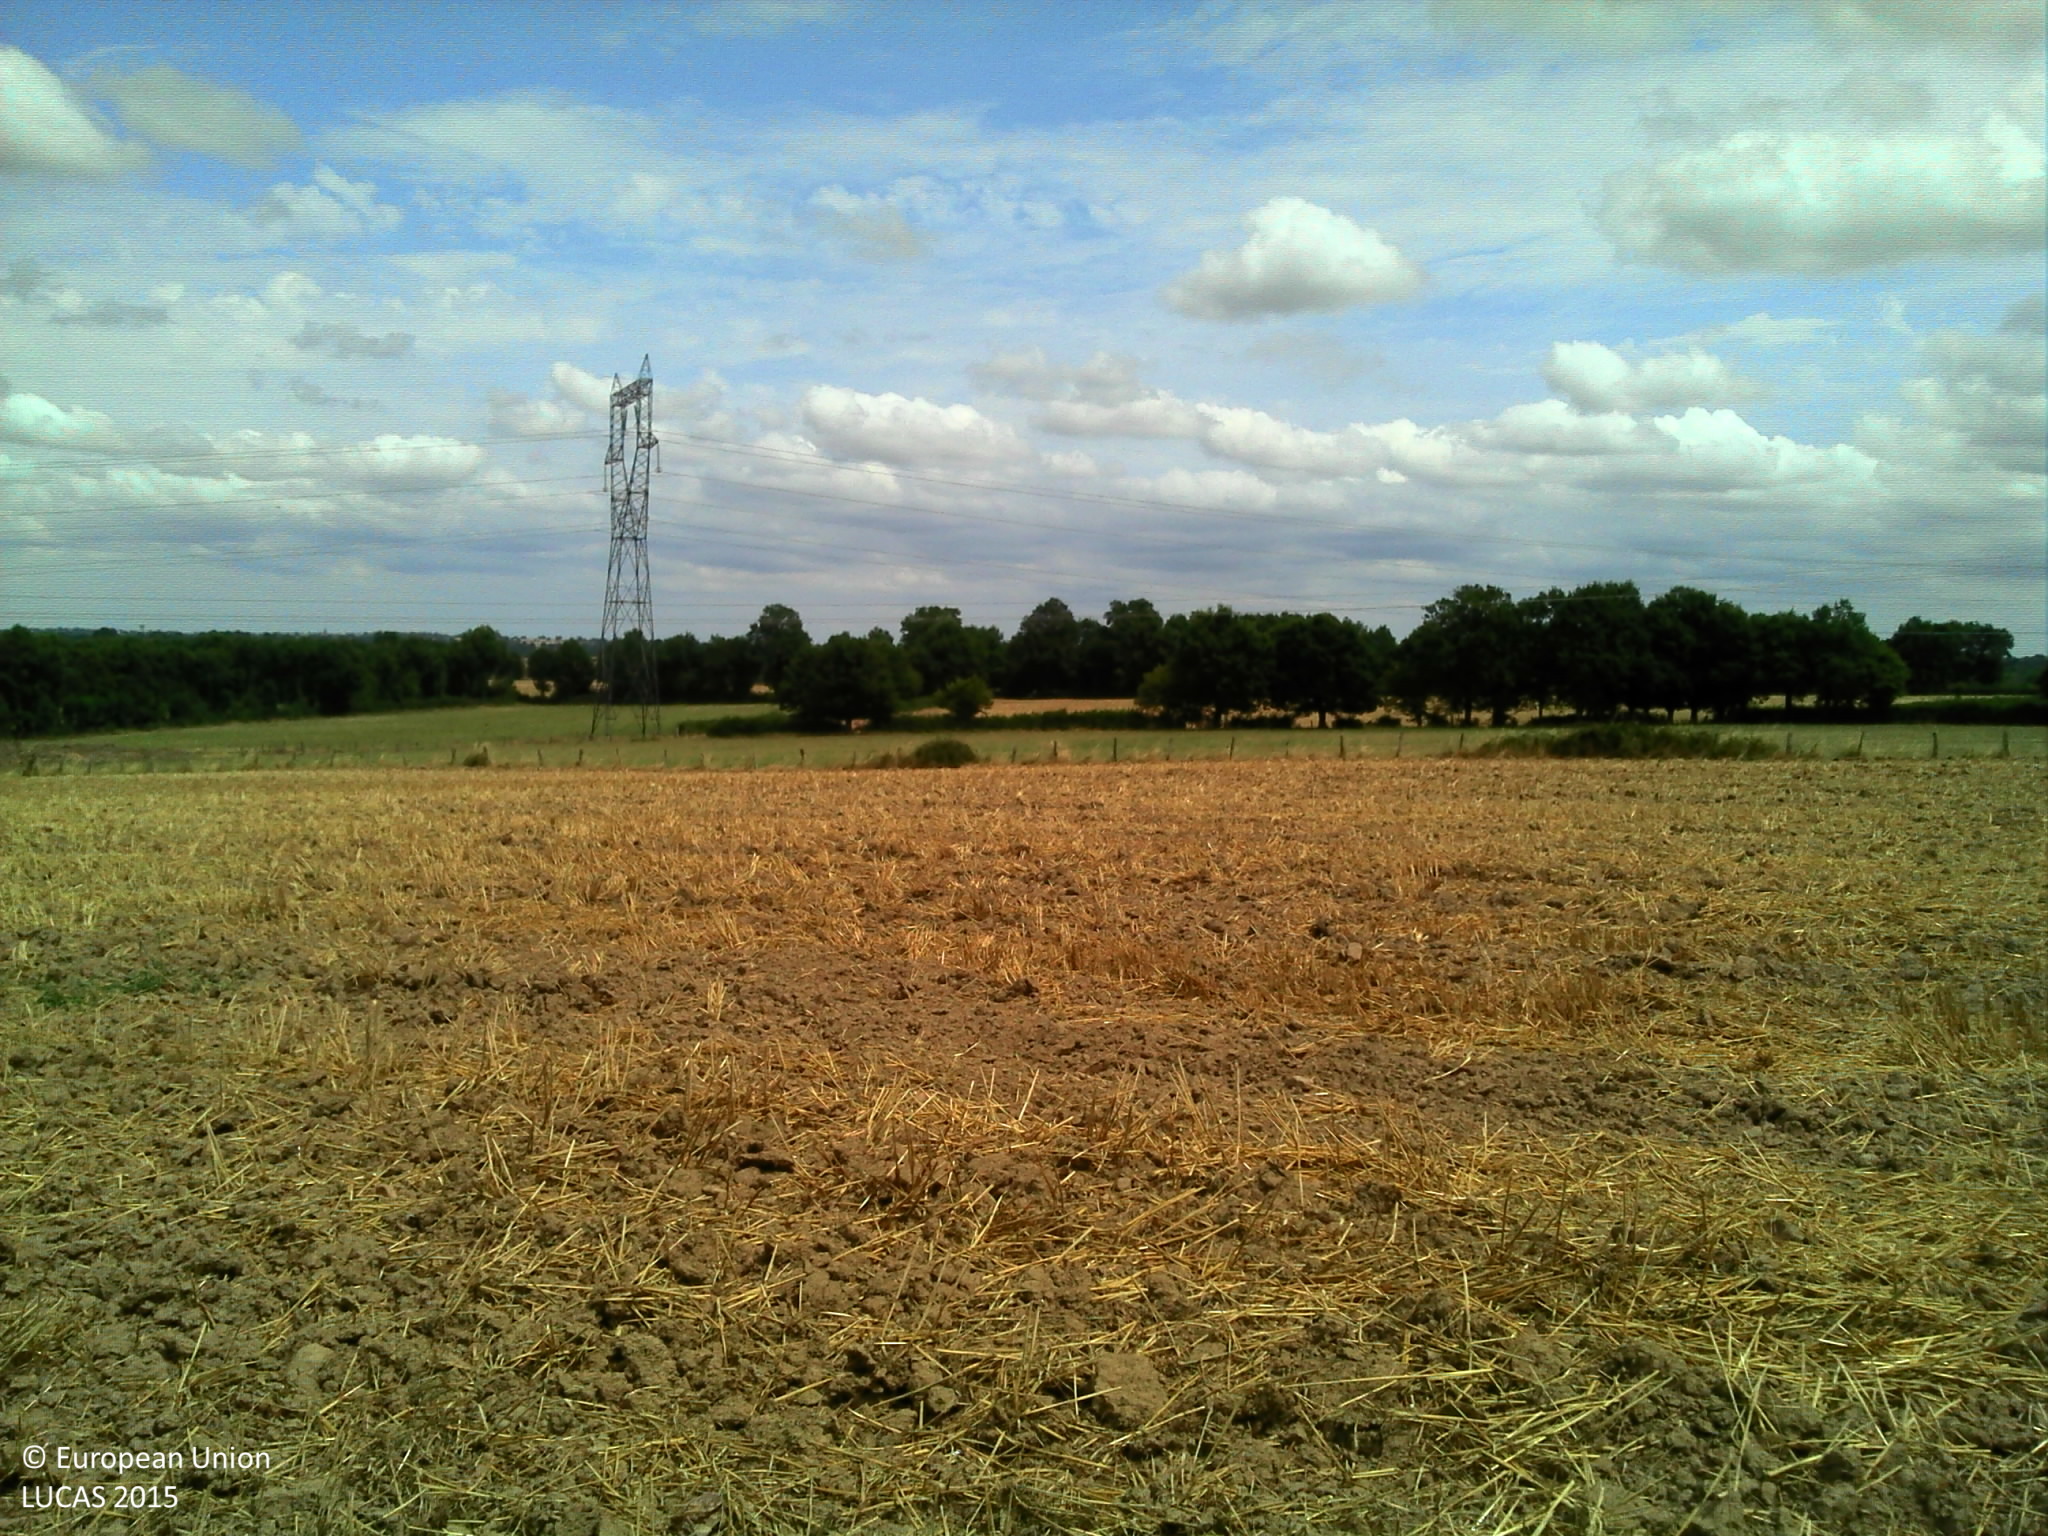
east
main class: Cropland
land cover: Barley
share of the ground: > 75 %
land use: Agriculture (excluding fallow land and kitchen gardens)
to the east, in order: Barley; Fences; Grassland without tree/shrub cover; Electric lines; Grassland without tree/shrub cover; Broadleaved woodland; Fences; Grassland without tree/shrub cover
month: July
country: FR
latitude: 46.6071
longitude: 2.9595
